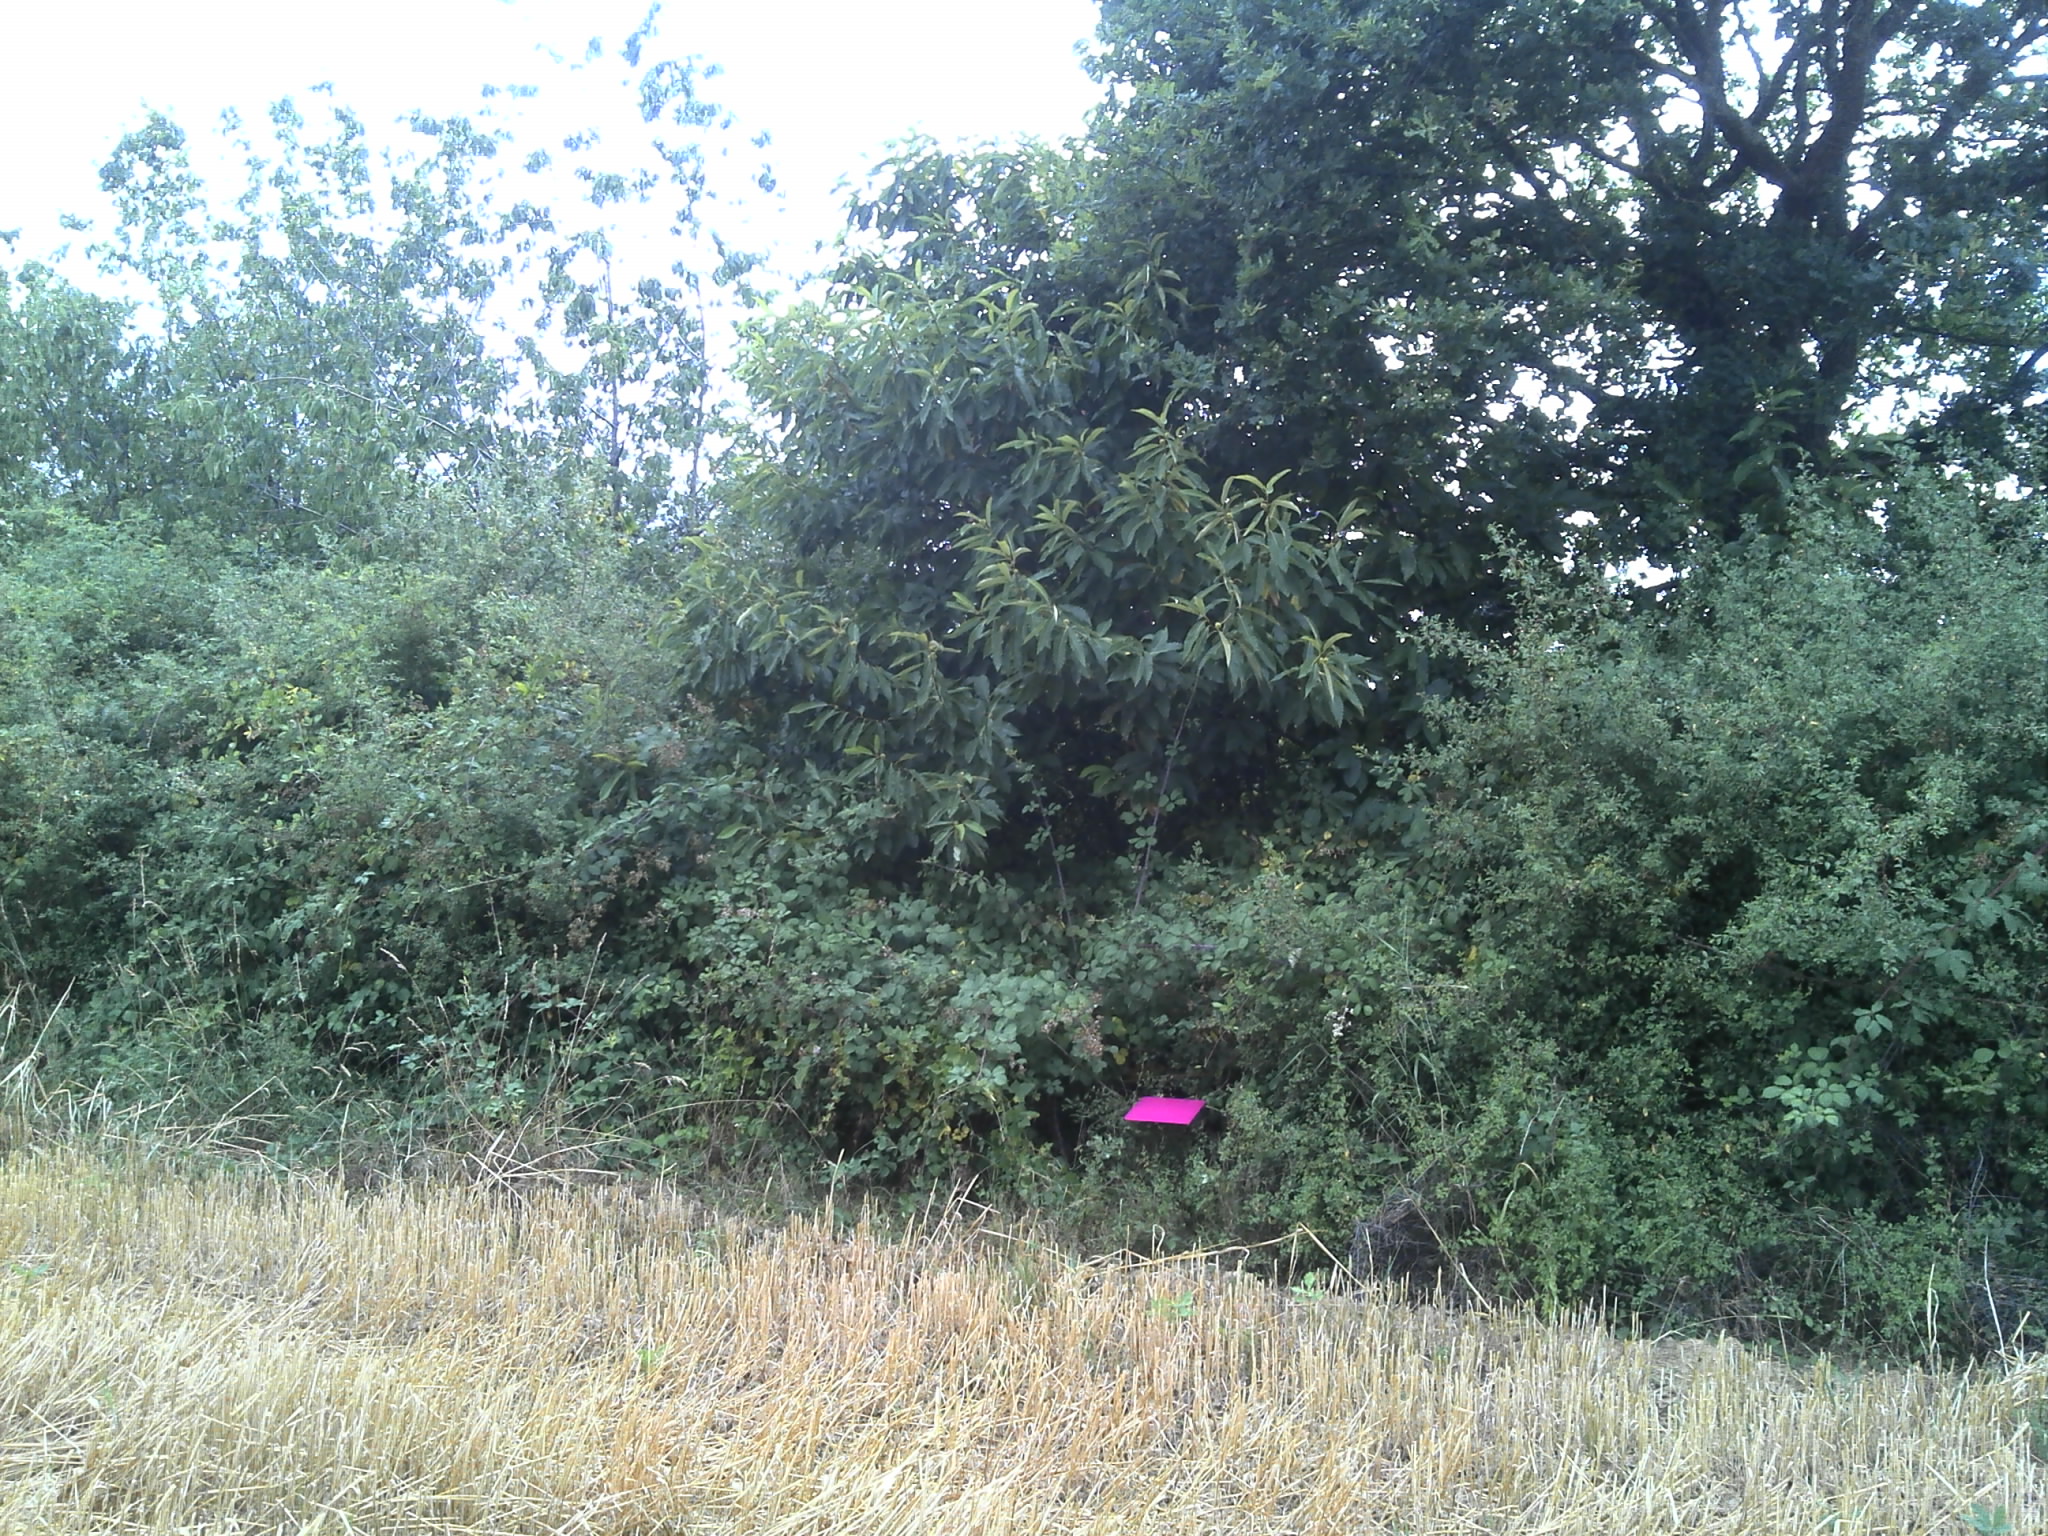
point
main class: Cropland
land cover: Barley
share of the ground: > 75 %
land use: Agriculture (excluding fallow land and kitchen gardens)
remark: Harvested field
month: July
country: FR
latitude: 46.4681
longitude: 1.5384
